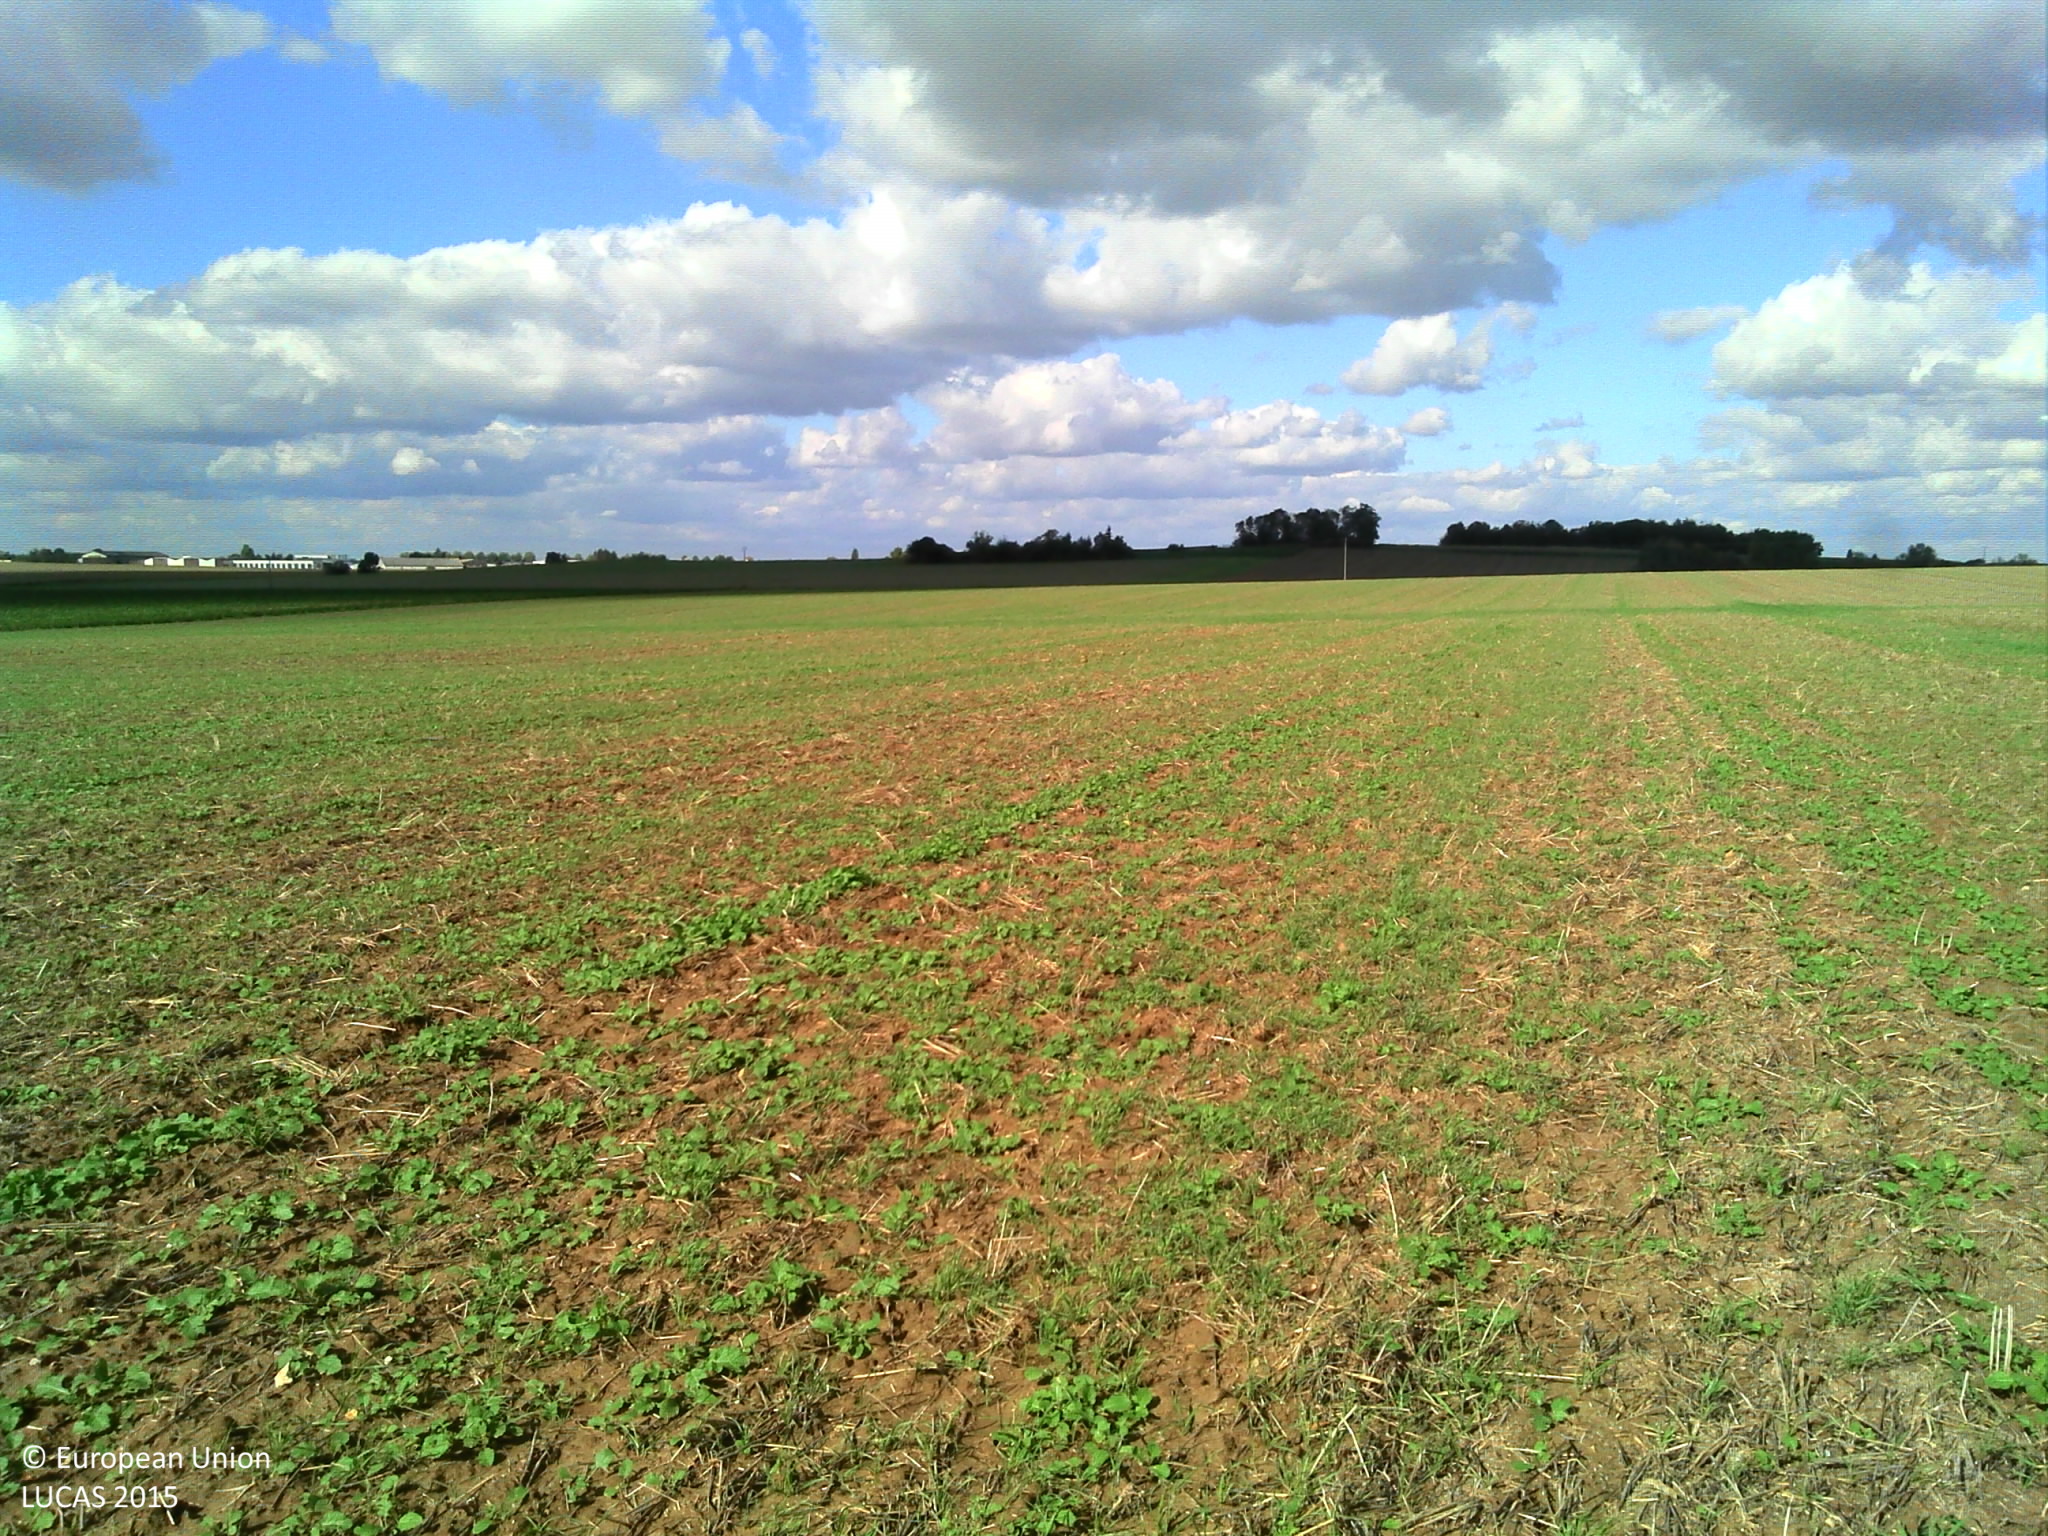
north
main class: Cropland
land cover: Common wheat
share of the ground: < 10 %
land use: Agriculture (excluding fallow land and kitchen gardens)
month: September
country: FR
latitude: 48.5454
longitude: 3.0430
